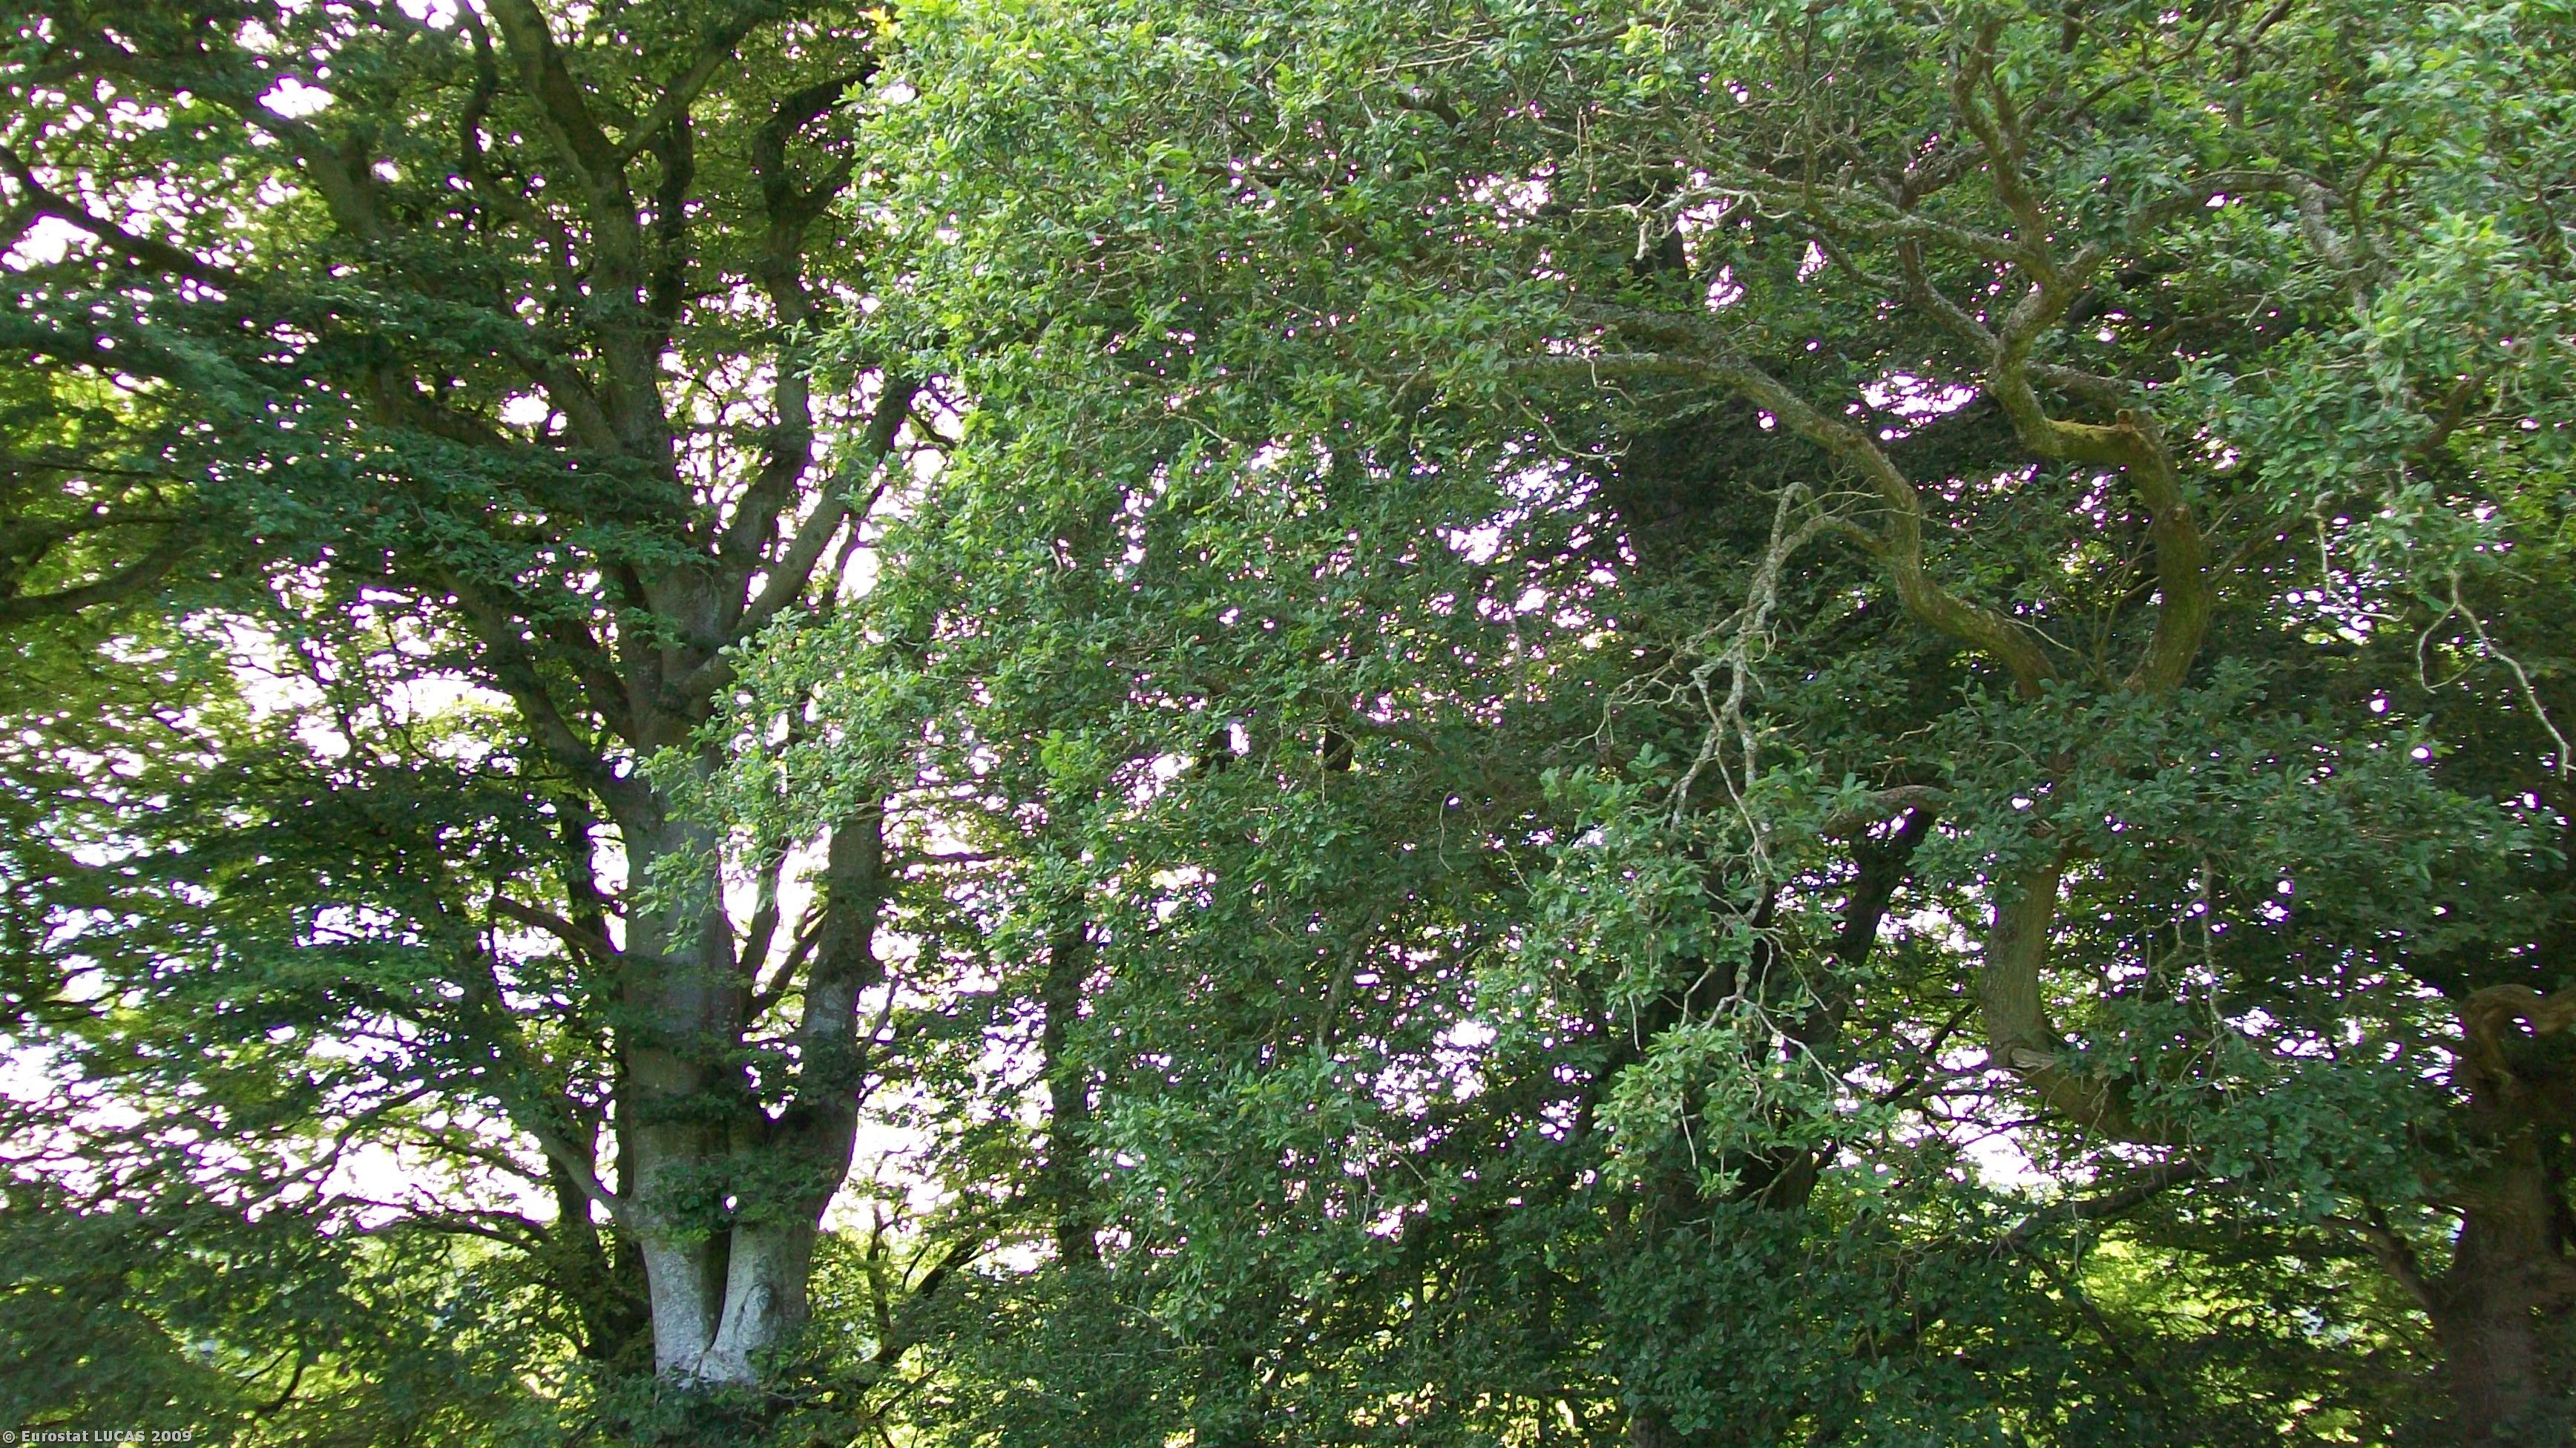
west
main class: Grassland
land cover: Grassland without tree/shrub cover
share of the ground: > 75 %
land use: Agriculture (excluding fallow land and kitchen gardens)
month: July
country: GB
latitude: 55.0030
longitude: -3.9254
